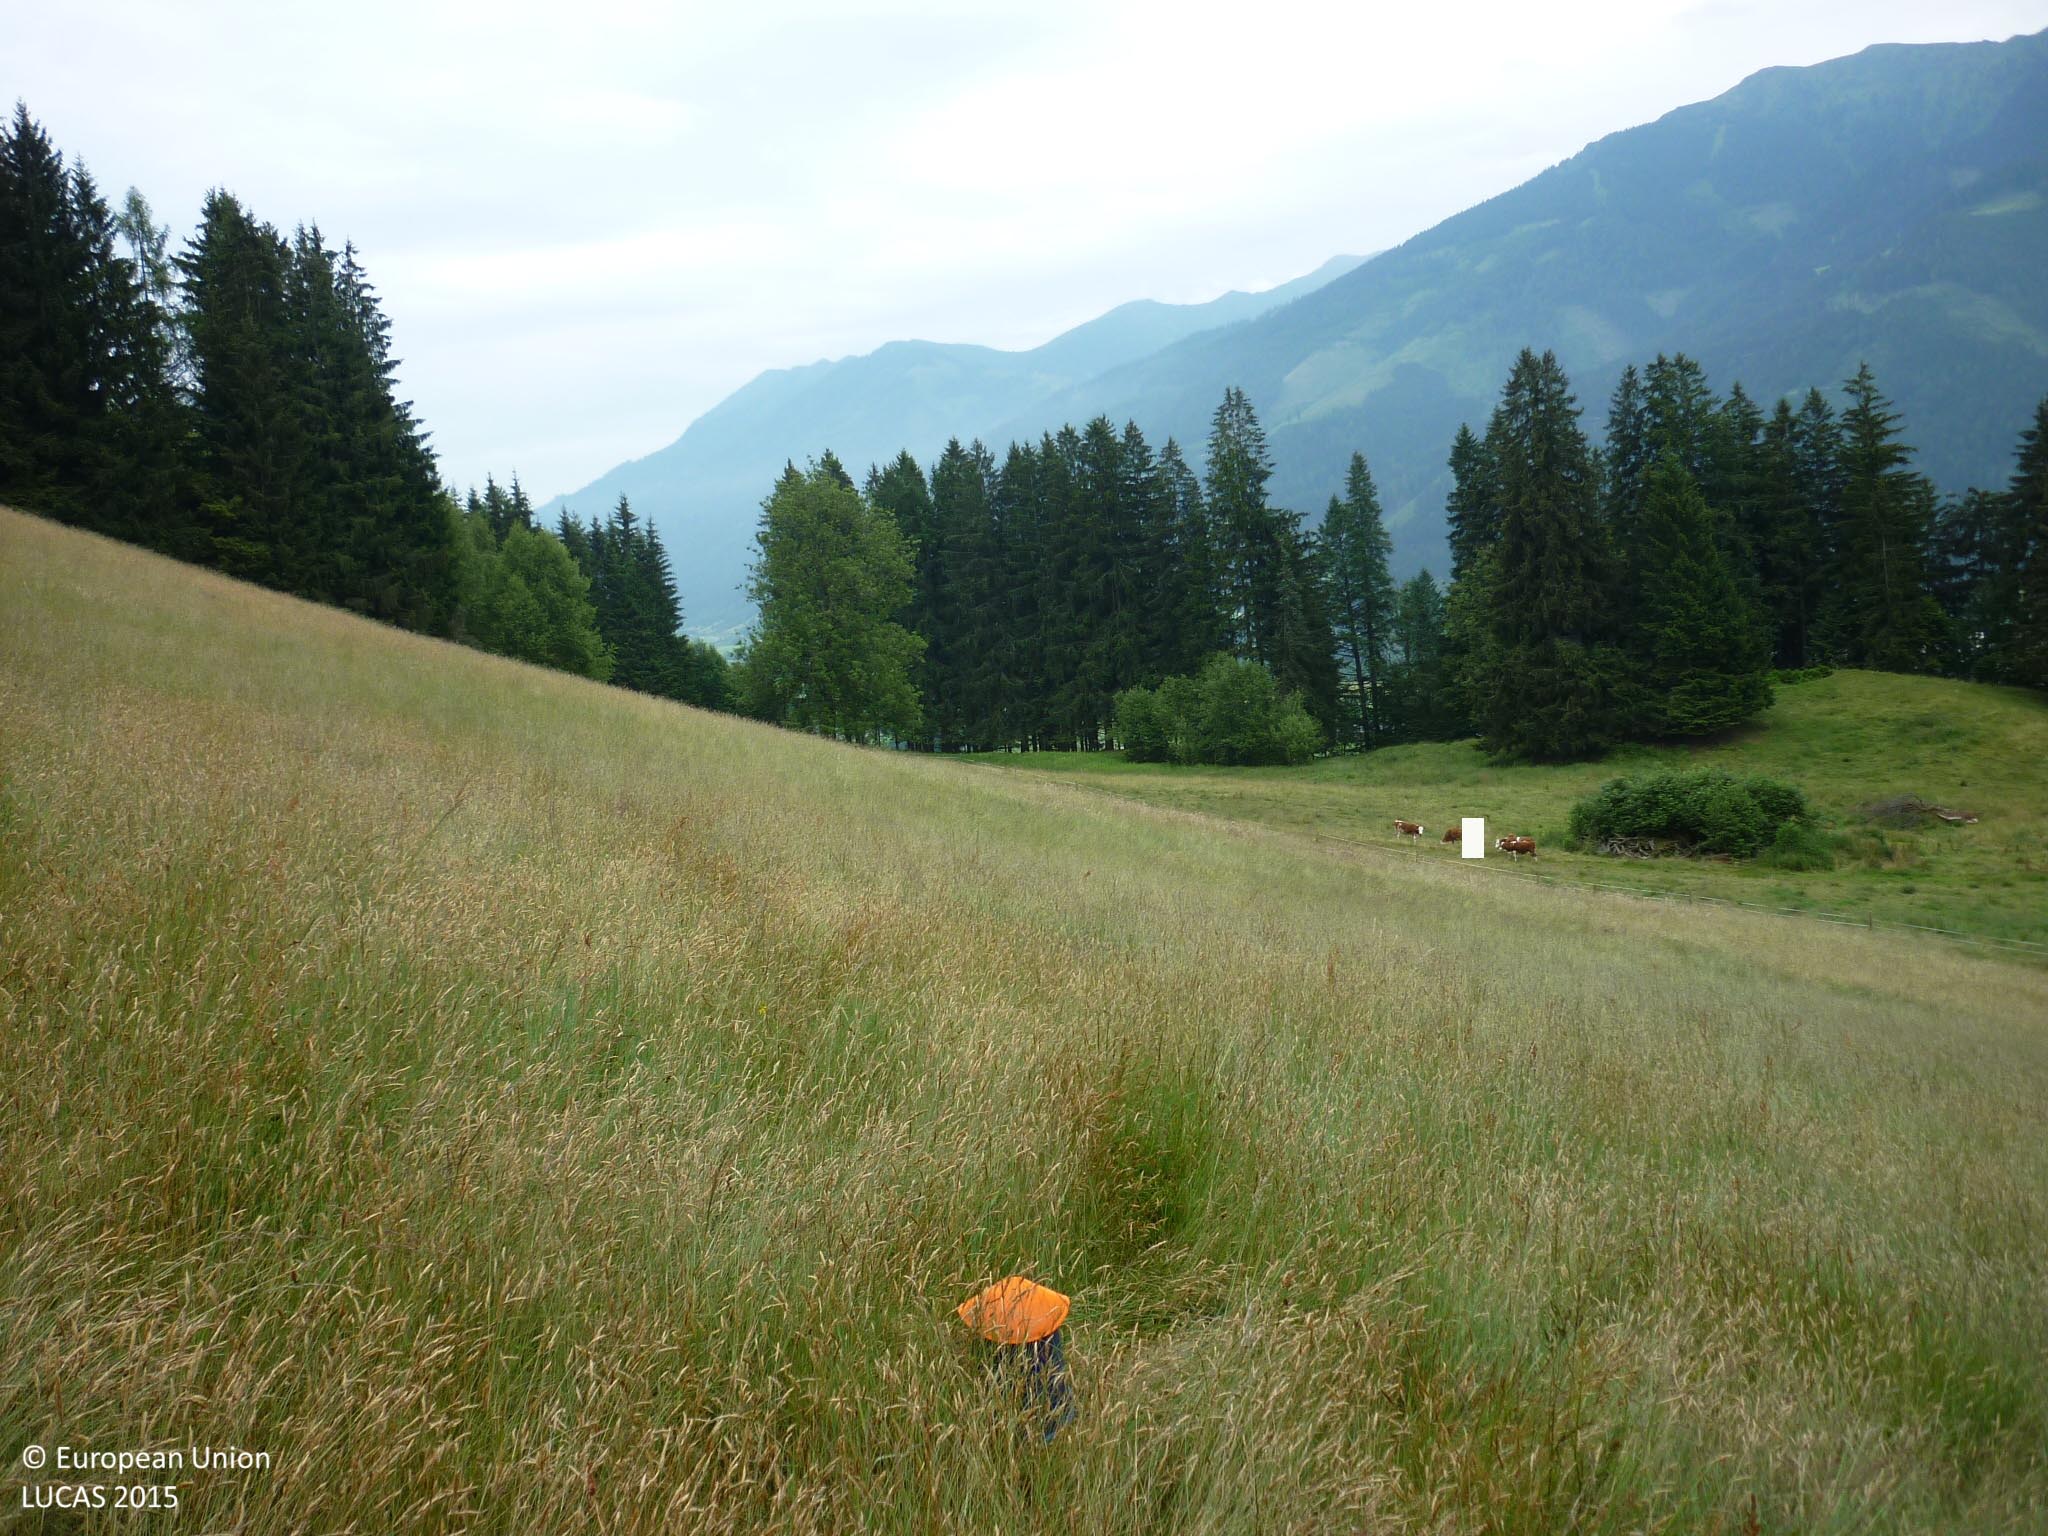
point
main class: Grassland
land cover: Grassland without tree/shrub cover
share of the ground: > 75 %
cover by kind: herbaceous plants 100 %
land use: Agriculture (excluding fallow land and kitchen gardens)
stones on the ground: < 10 %
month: June
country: AT
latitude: 47.4998
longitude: 14.5260
